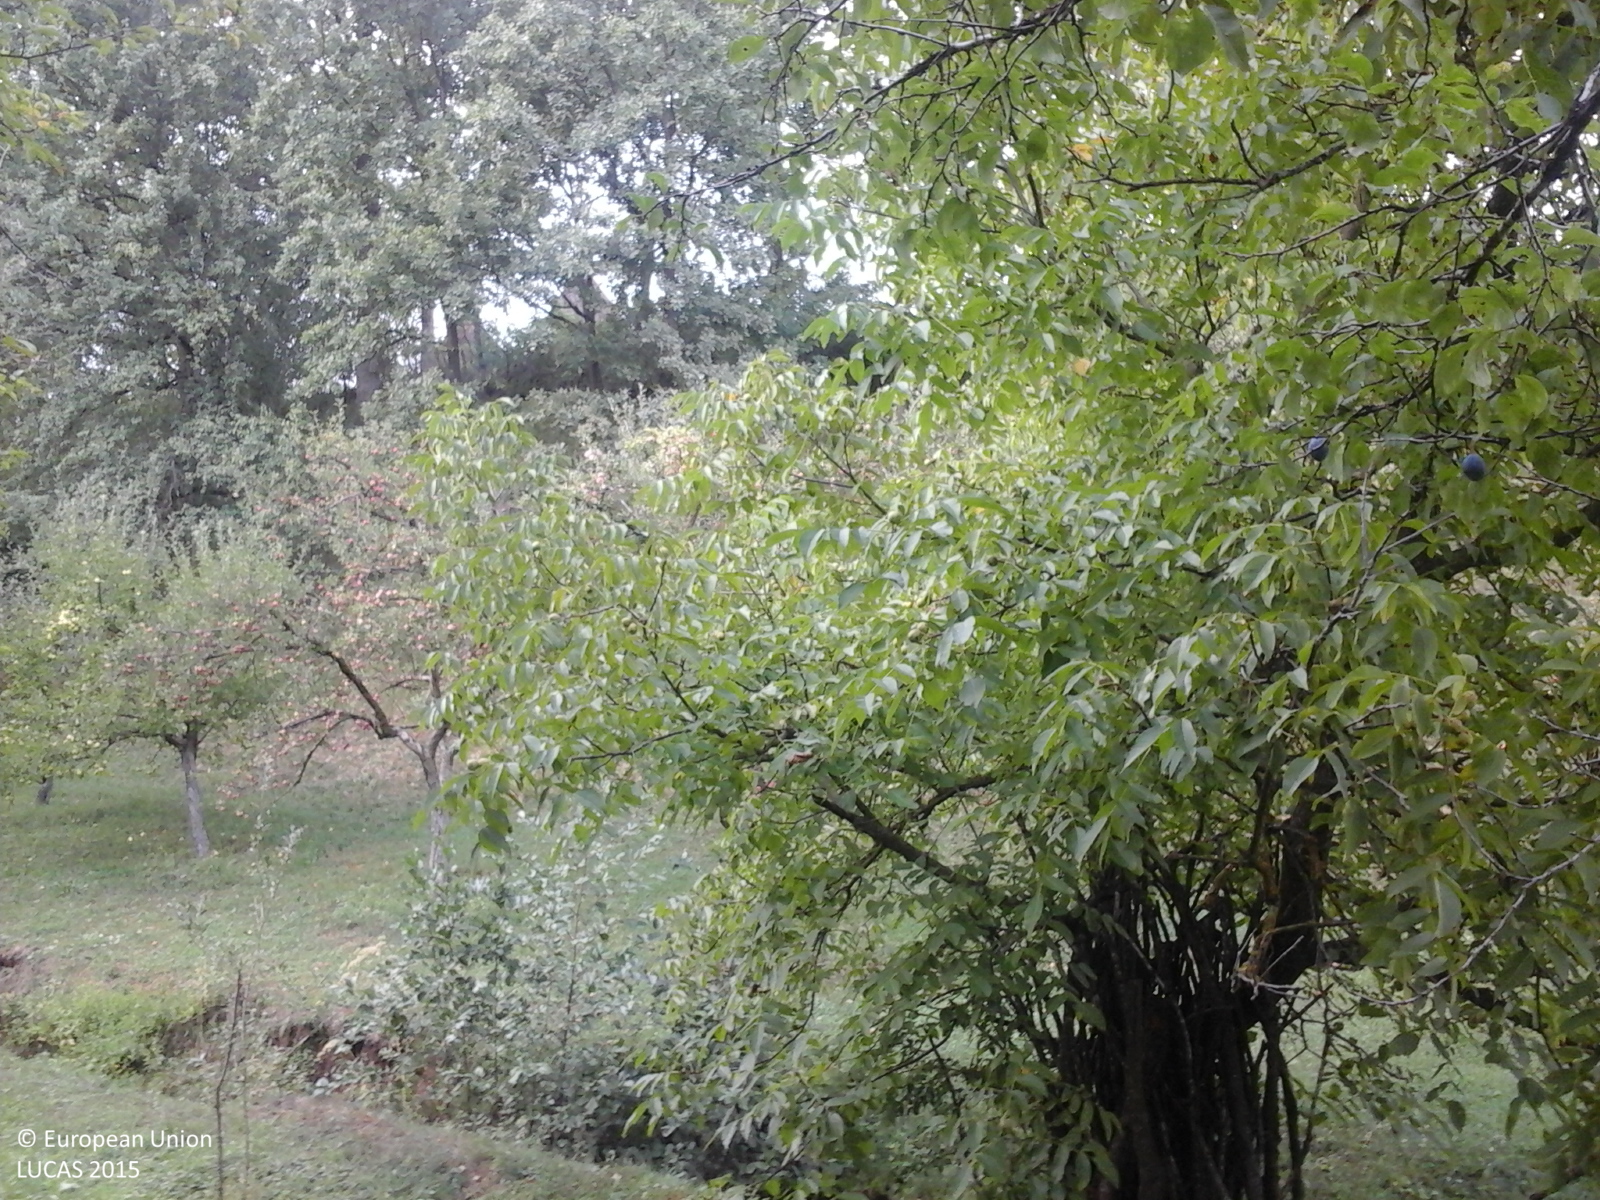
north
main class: Cropland
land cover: Other fruit trees and berries
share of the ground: 50 - 75 %
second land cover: Grassland without tree/shrub cover
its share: > 75 %
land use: Agriculture (excluding fallow land and kitchen gardens)
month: September
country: RO
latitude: 47.7940
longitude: 23.9000
